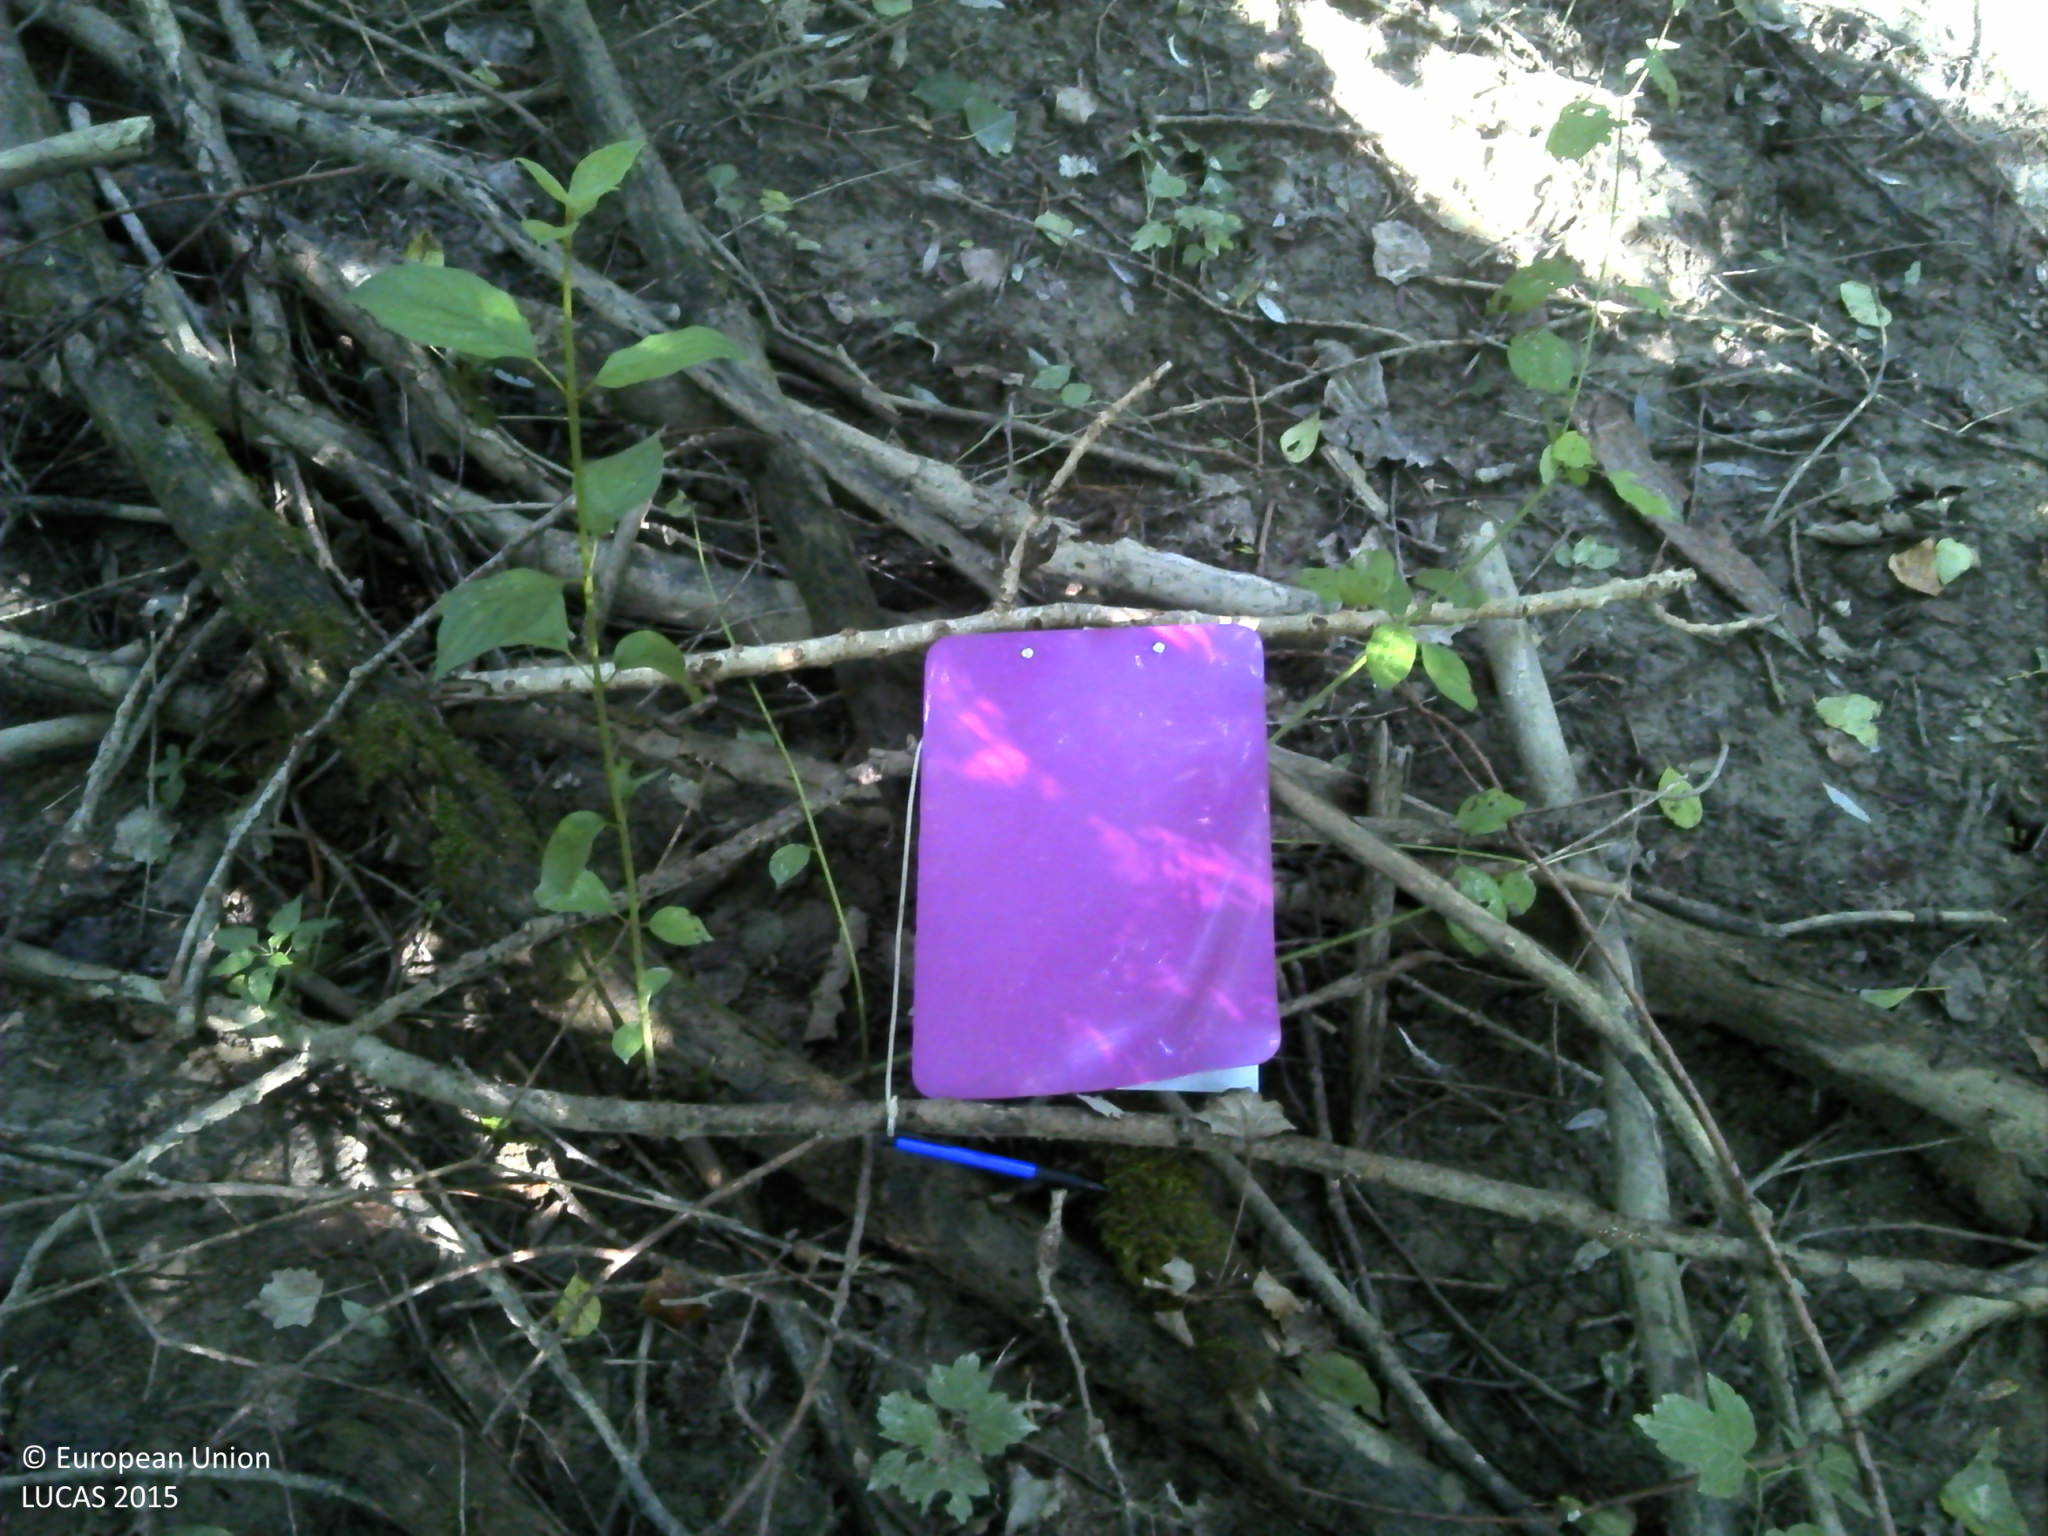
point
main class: Woodland
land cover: Broadleaved woodland
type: mesophytic deciduous forest
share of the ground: > 75 %
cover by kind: broadleaved forest trees 100 %
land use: Forestry
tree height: > 5 m
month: September
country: HR
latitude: 45.6206
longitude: 16.3466
